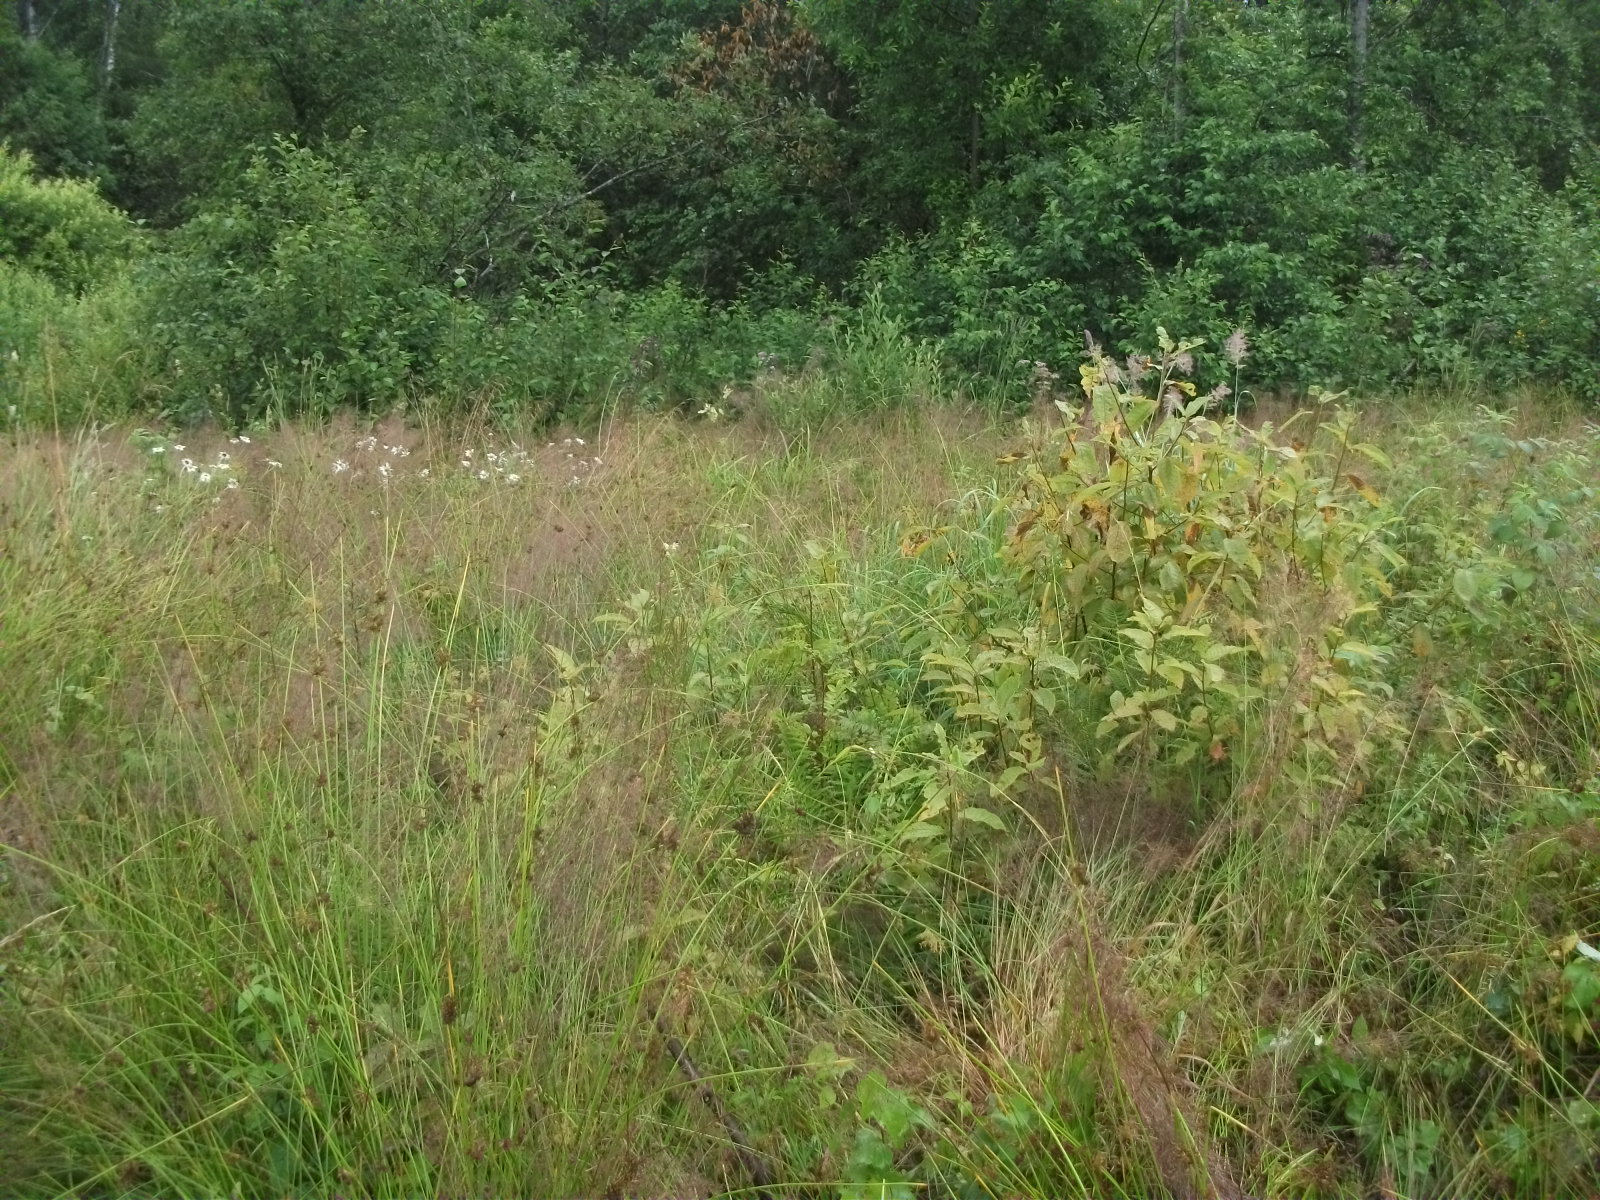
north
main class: Shrubland
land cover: Shrubland with sparse tree cover
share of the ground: > 75 %
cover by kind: shrubs 75 %, herbaceous plants 15 %, broadleaved forest trees 5 %, lichens and mosses 5 %
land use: Forestry
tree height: < 5 m
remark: Clear cut
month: July
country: LV
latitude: 56.8157
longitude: 25.8040
